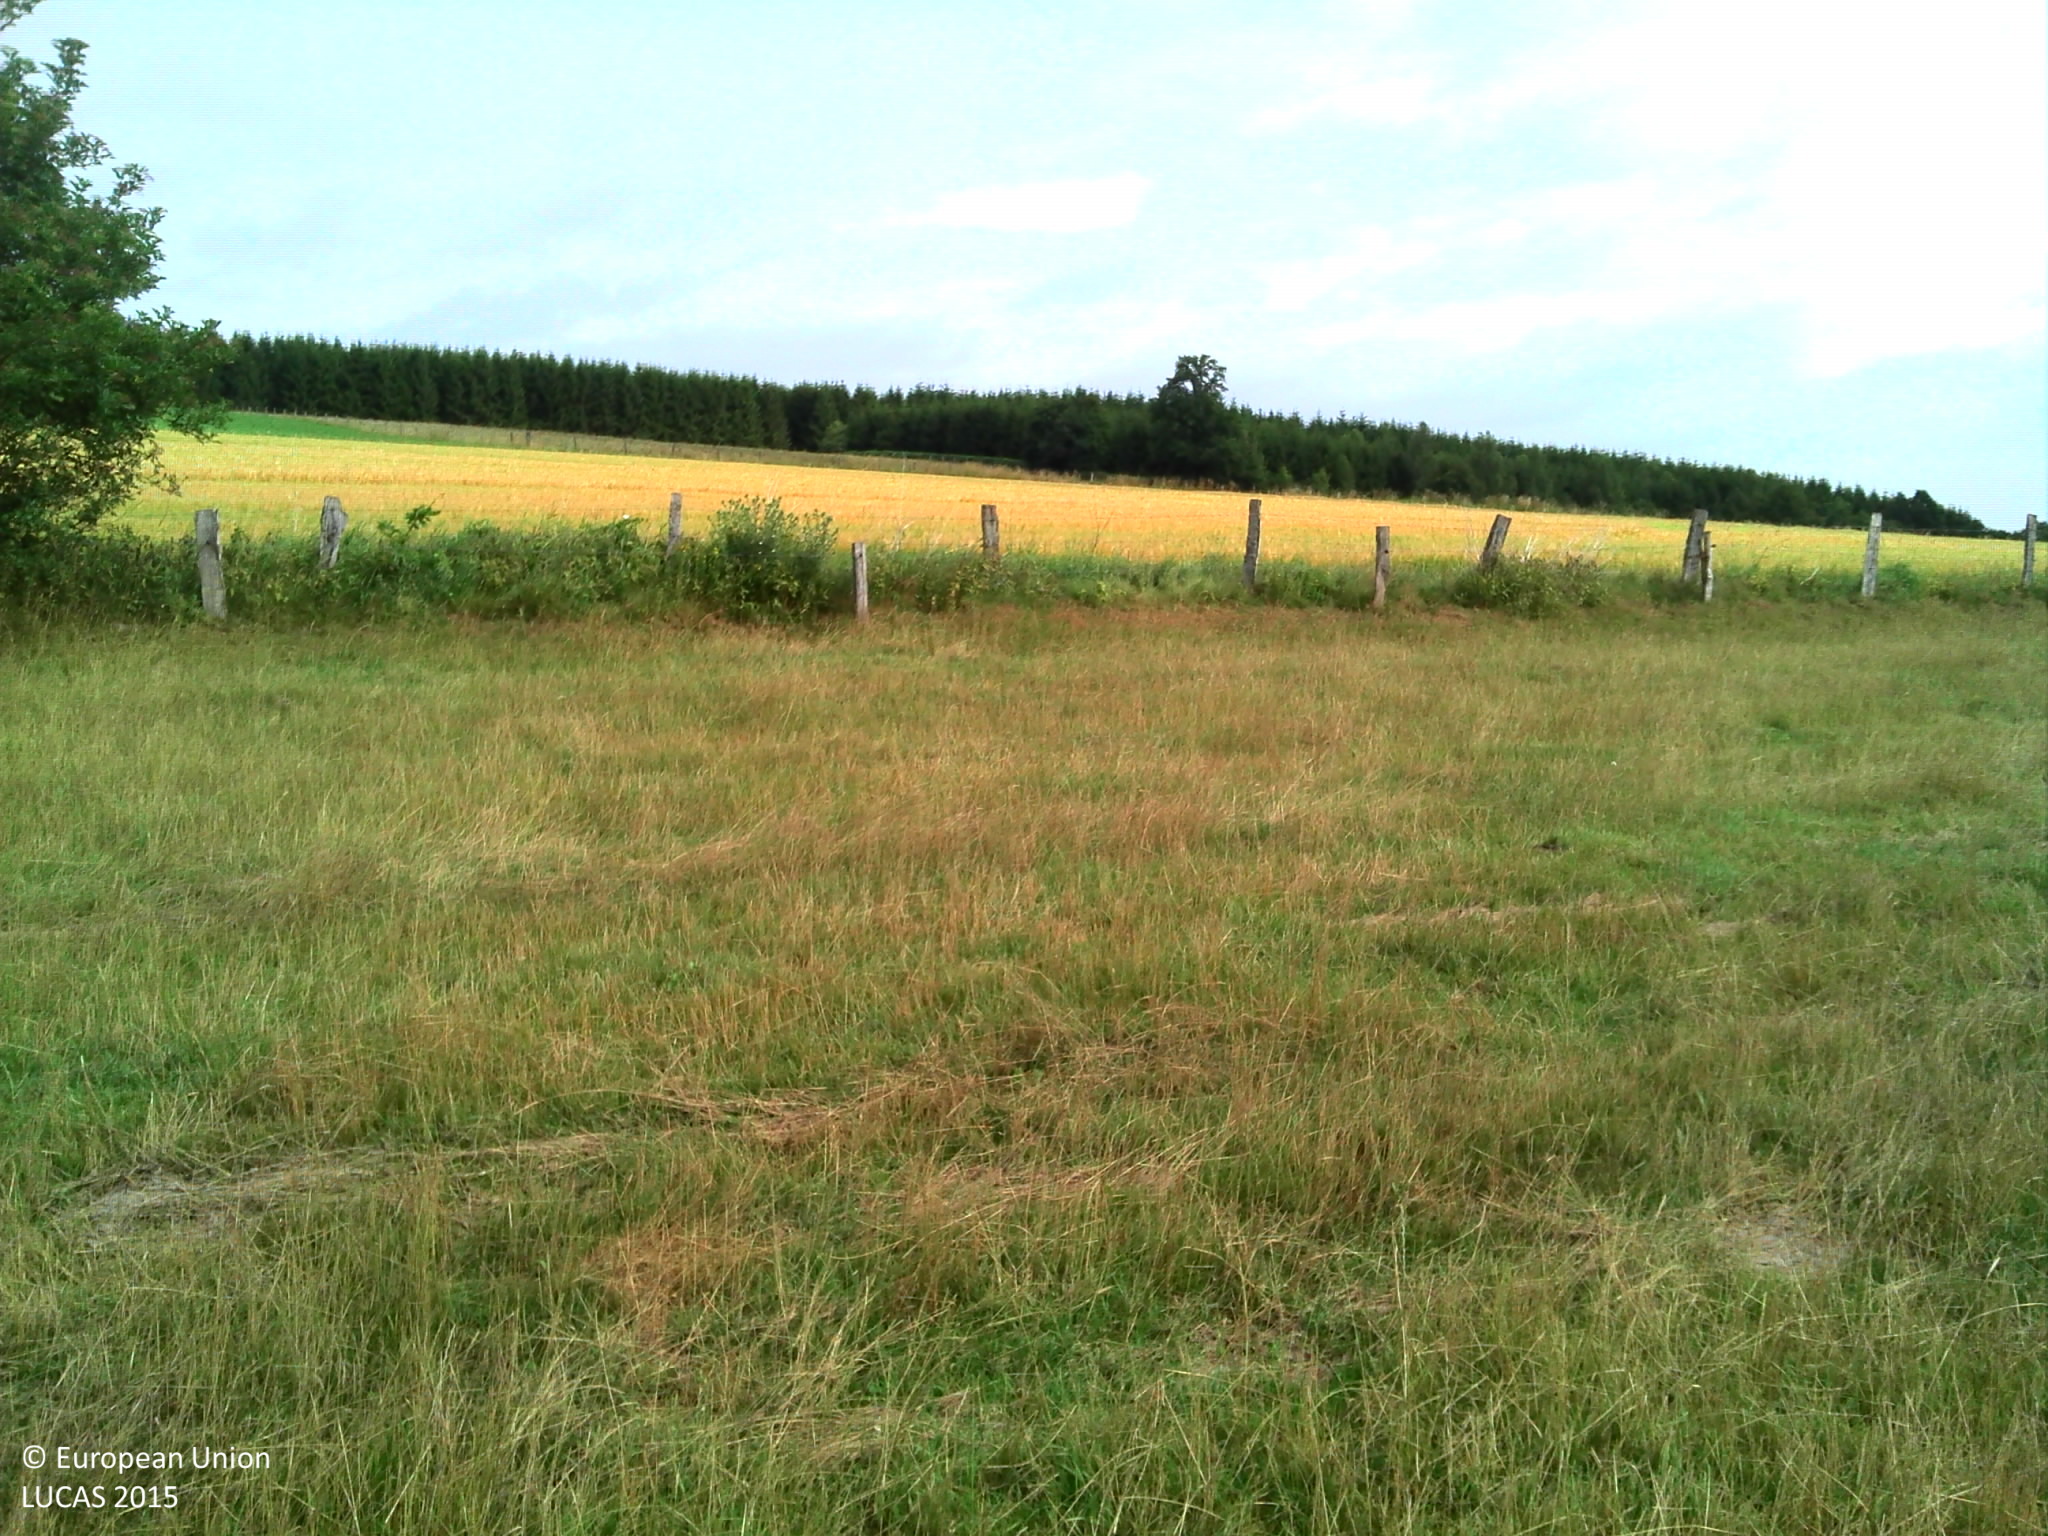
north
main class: Grassland
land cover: Grassland without tree/shrub cover
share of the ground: > 75 %
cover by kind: herbaceous plants 100 %
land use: Agriculture (excluding fallow land and kitchen gardens)
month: July
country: BE
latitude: 49.8346
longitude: 5.2848
